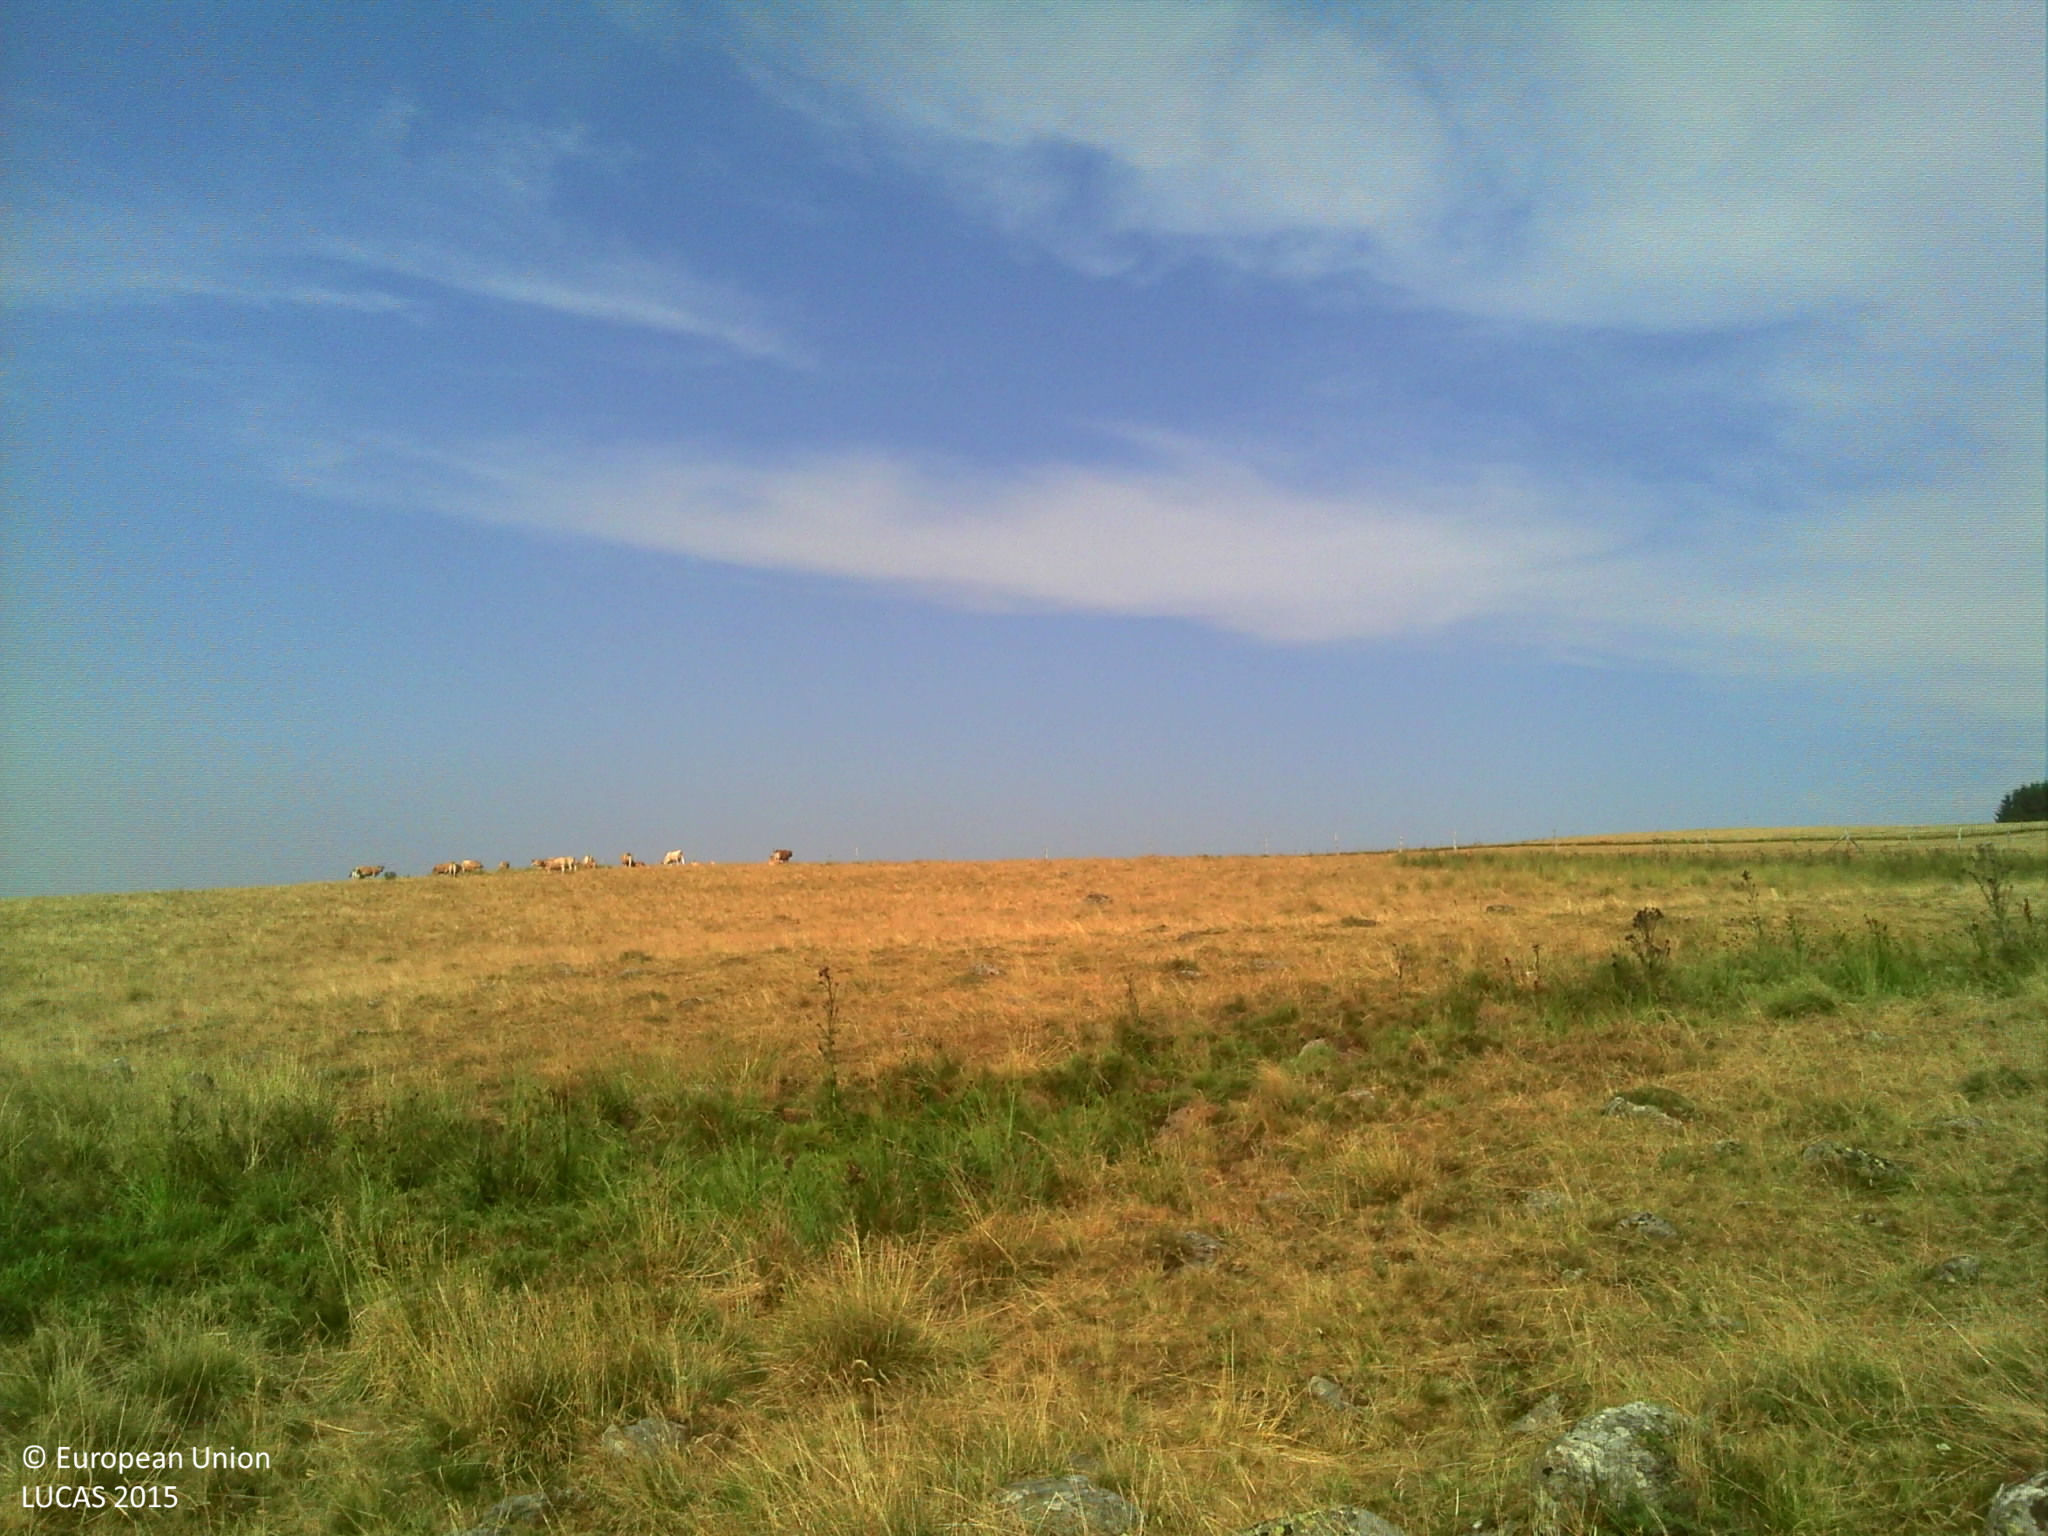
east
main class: Grassland
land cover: Grassland without tree/shrub cover
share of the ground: > 75 %
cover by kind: herbaceous plants 95 %, shrubs 5 %
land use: Agriculture (excluding fallow land and kitchen gardens)
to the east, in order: Grassland without tree/shrub cover; Rivers and streams; Fences; Grassland without tree/shrub cover; Fences
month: July
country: FR
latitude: 44.6050
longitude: 3.0362
